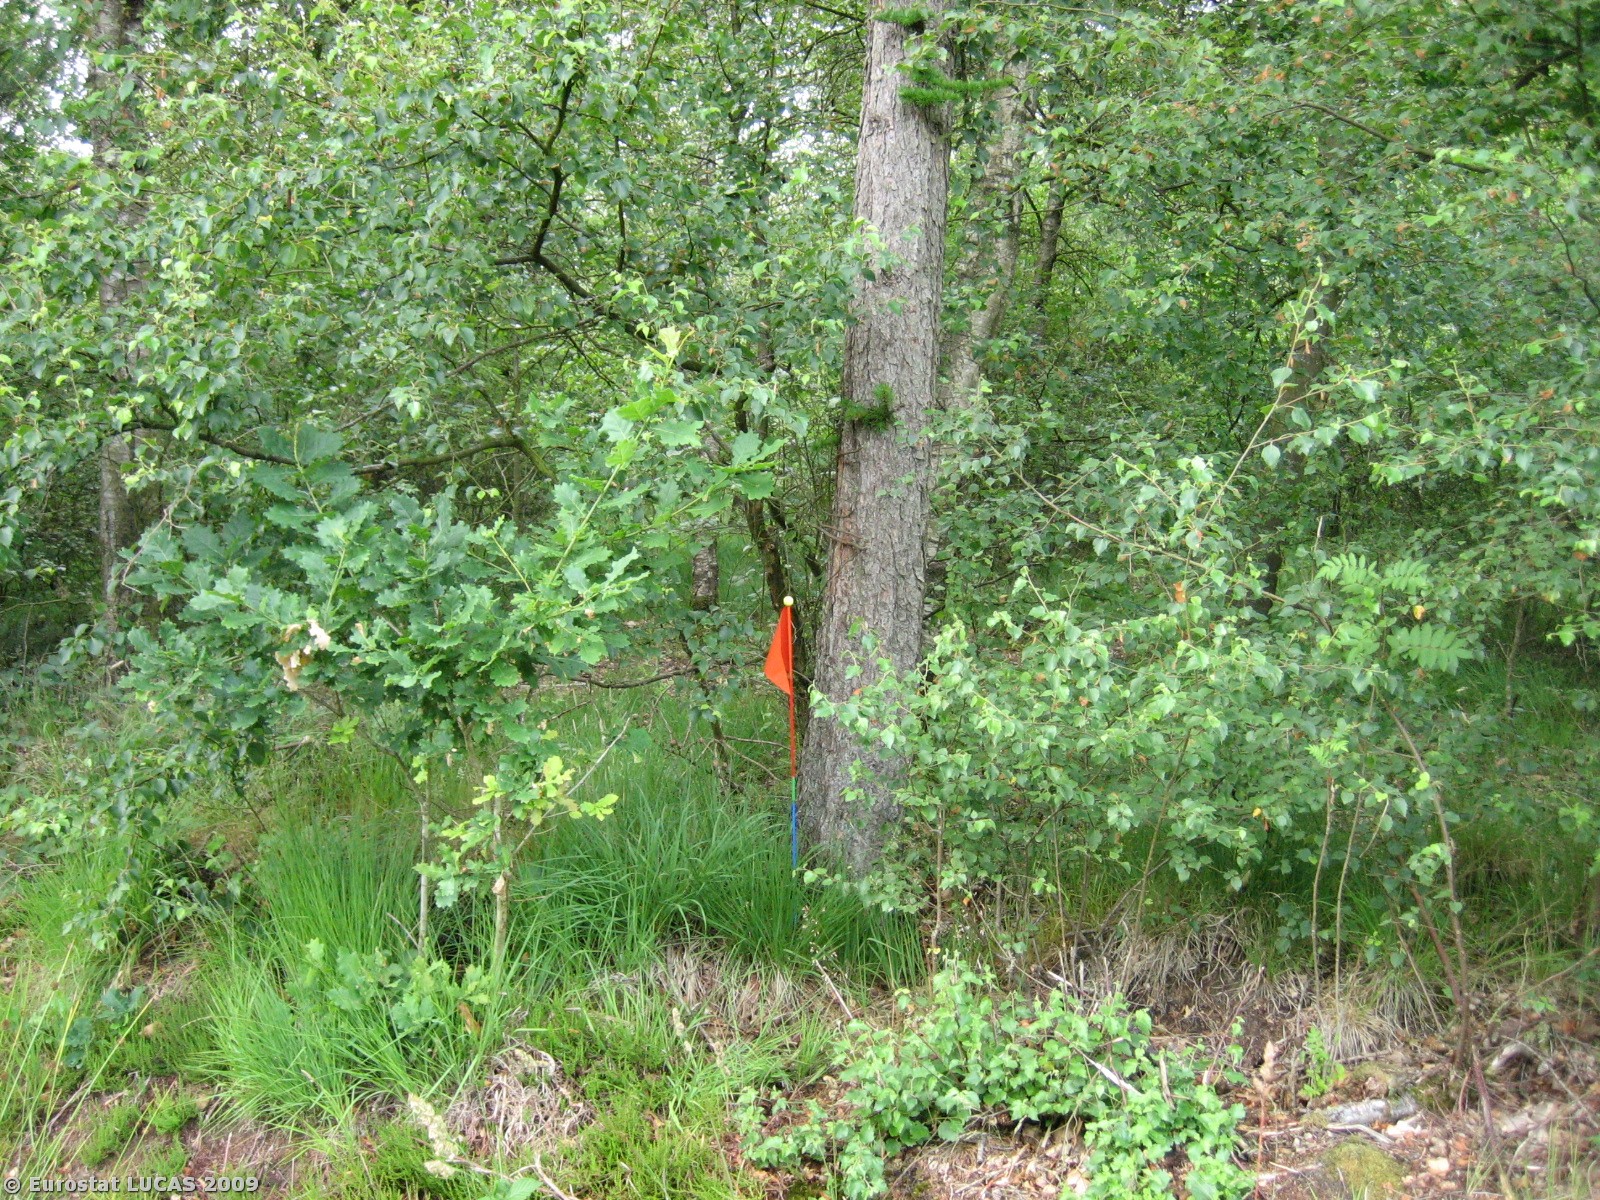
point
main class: Woodland
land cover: Mixed woodland
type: acidophilous oak and oak-birch forest
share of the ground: > 75 %
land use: Forestry
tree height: > 5 m
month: July
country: DK
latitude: 55.5489
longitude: 8.4322
